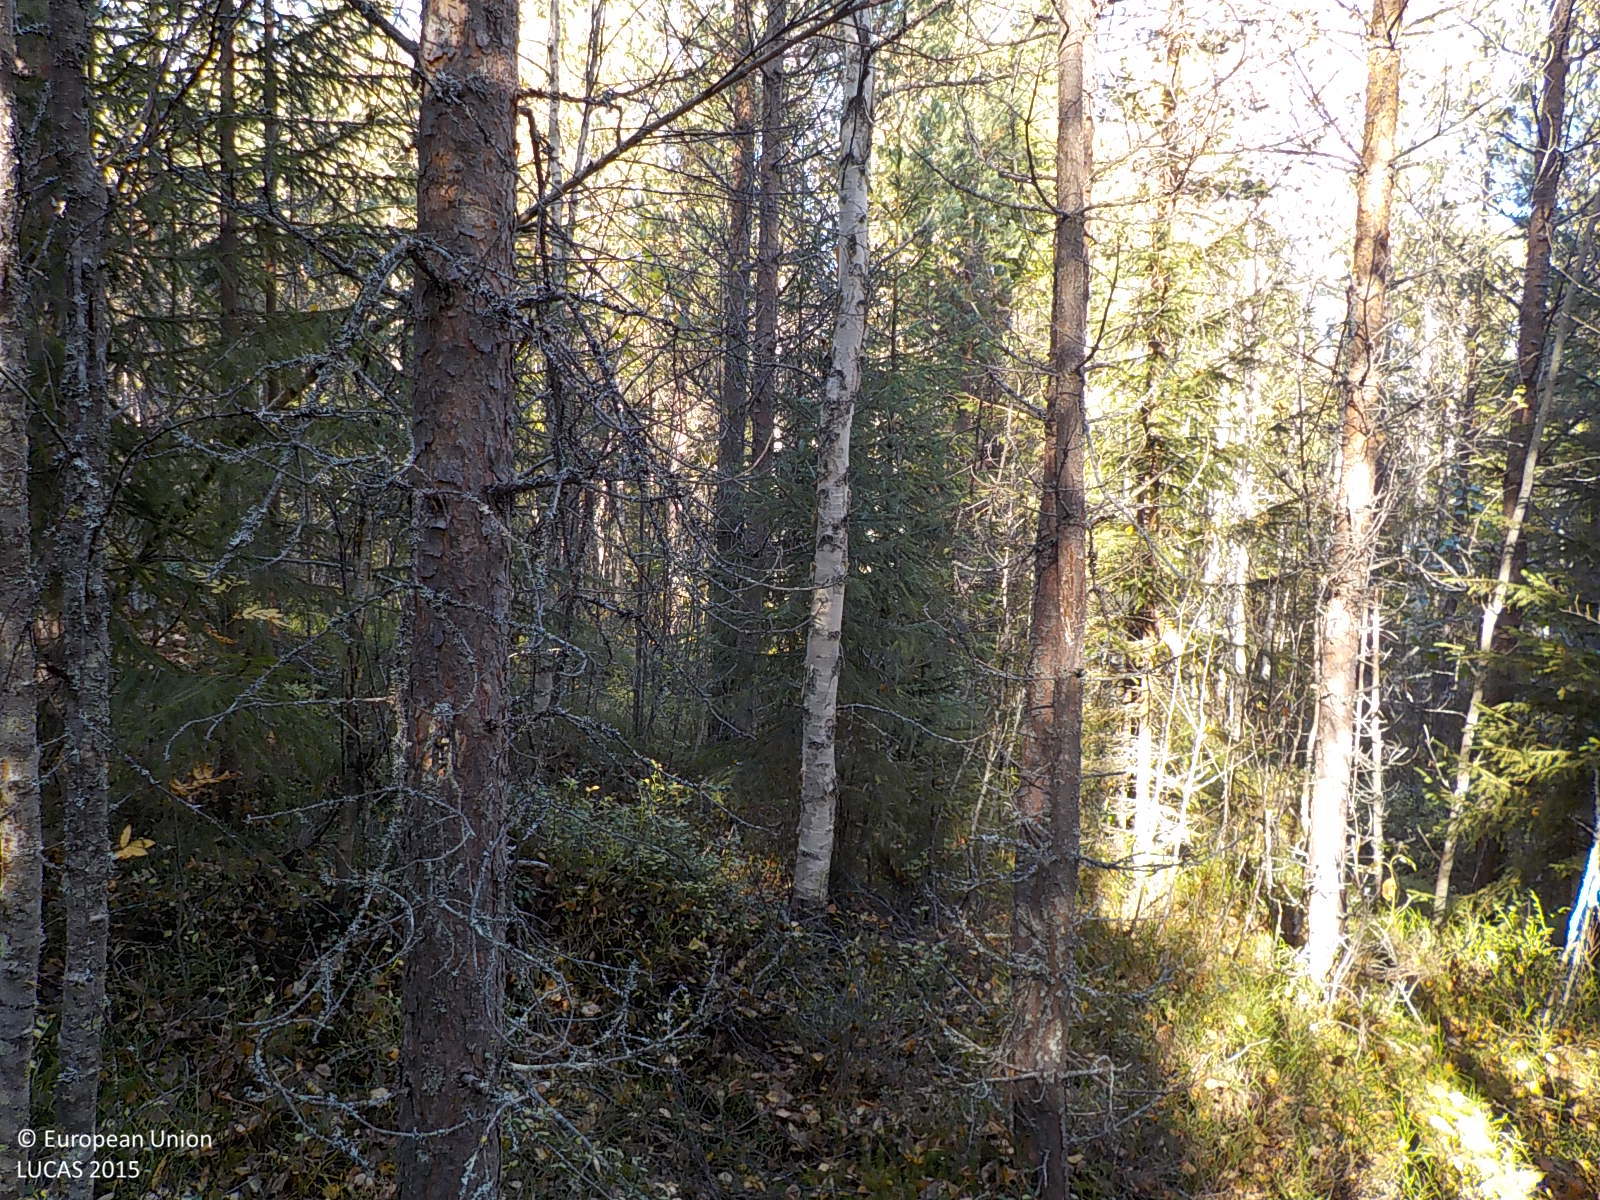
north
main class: Woodland
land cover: Other mixed woodland
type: boreal forest
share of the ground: > 75 %
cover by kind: coniferous forest trees 45 %, broadleaved forest trees 35 %, shrubs 10 %, herbaceous plants 10 %
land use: Forestry
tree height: > 5 m
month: September
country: SE
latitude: 63.4363
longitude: 17.2097
